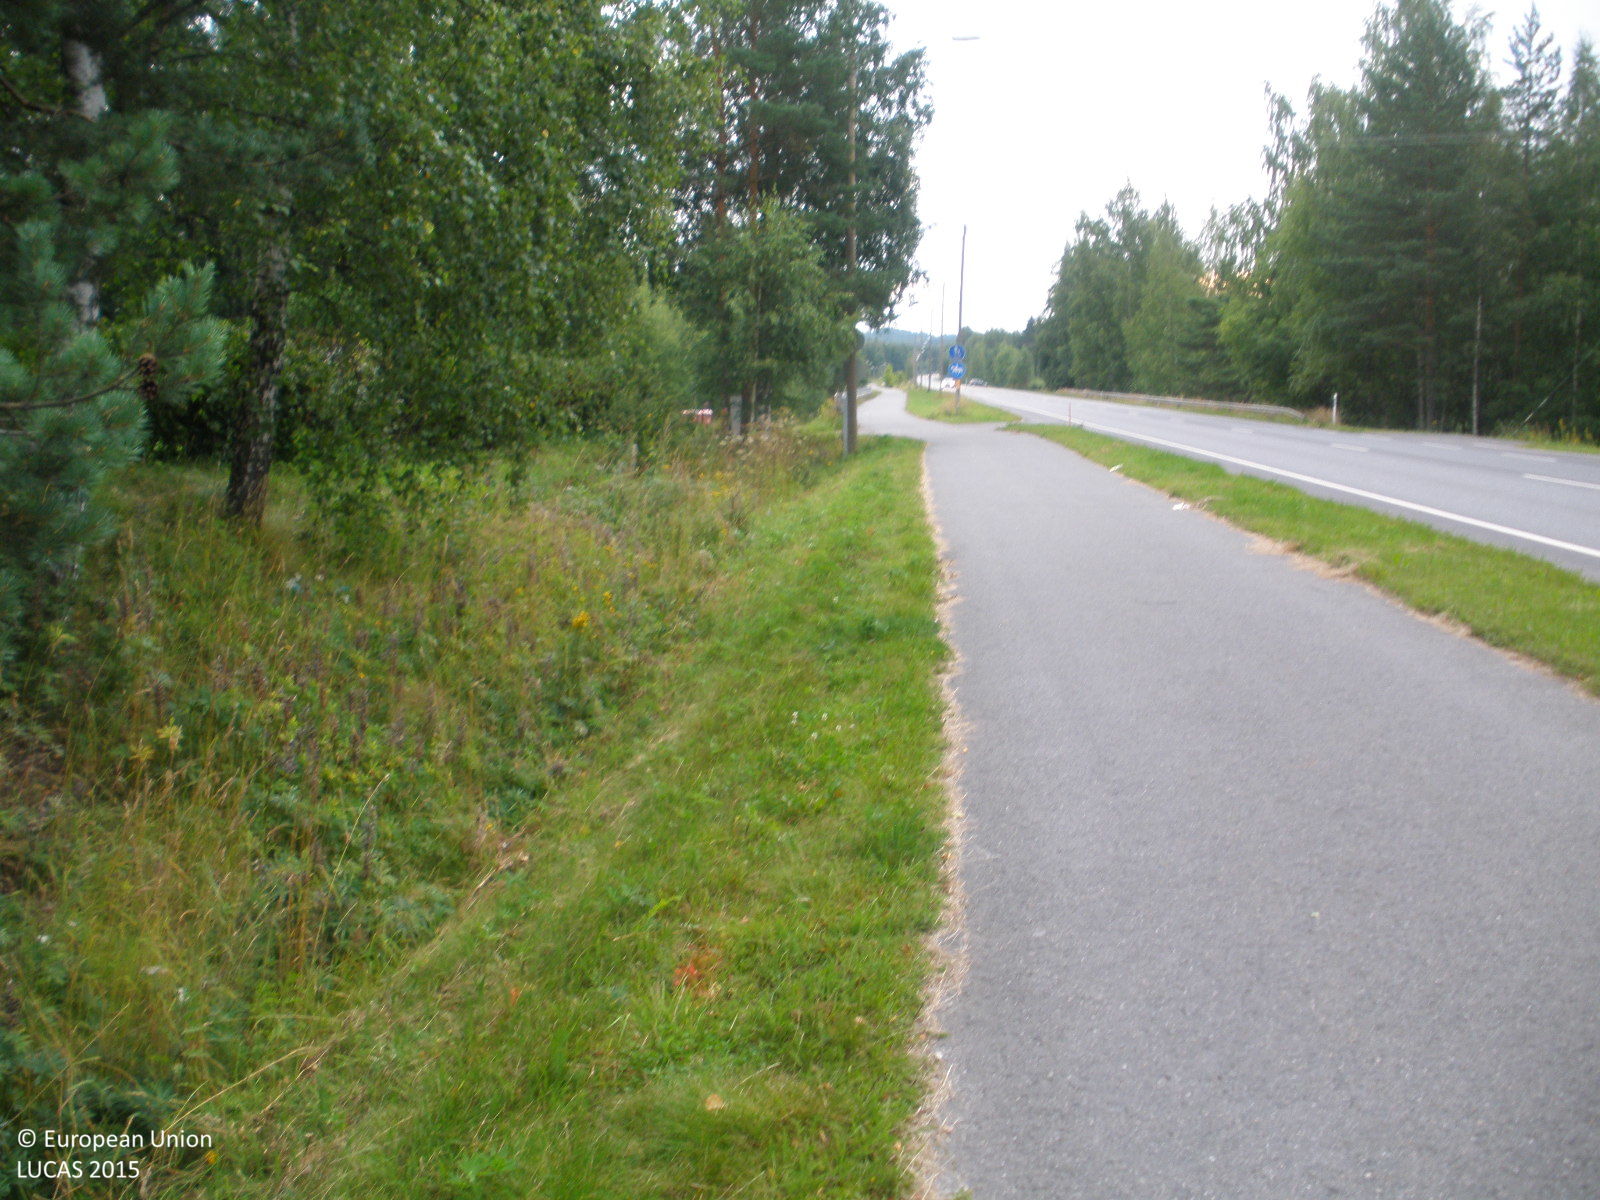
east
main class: Grassland
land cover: Grassland without tree/shrub cover
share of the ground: > 75 %
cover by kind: herbaceous plants 100 %
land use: Residential
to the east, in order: Grassland without tree/shrub cover; Artificial constructions in urban areas; Spruce dominated mixed woodland; Tracks; Broadleaved woodland; Rivers and streams; Broadleaved woodland; Electric lines; Broadleaved woodland
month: August
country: FI
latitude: 60.9612
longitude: 24.5649
